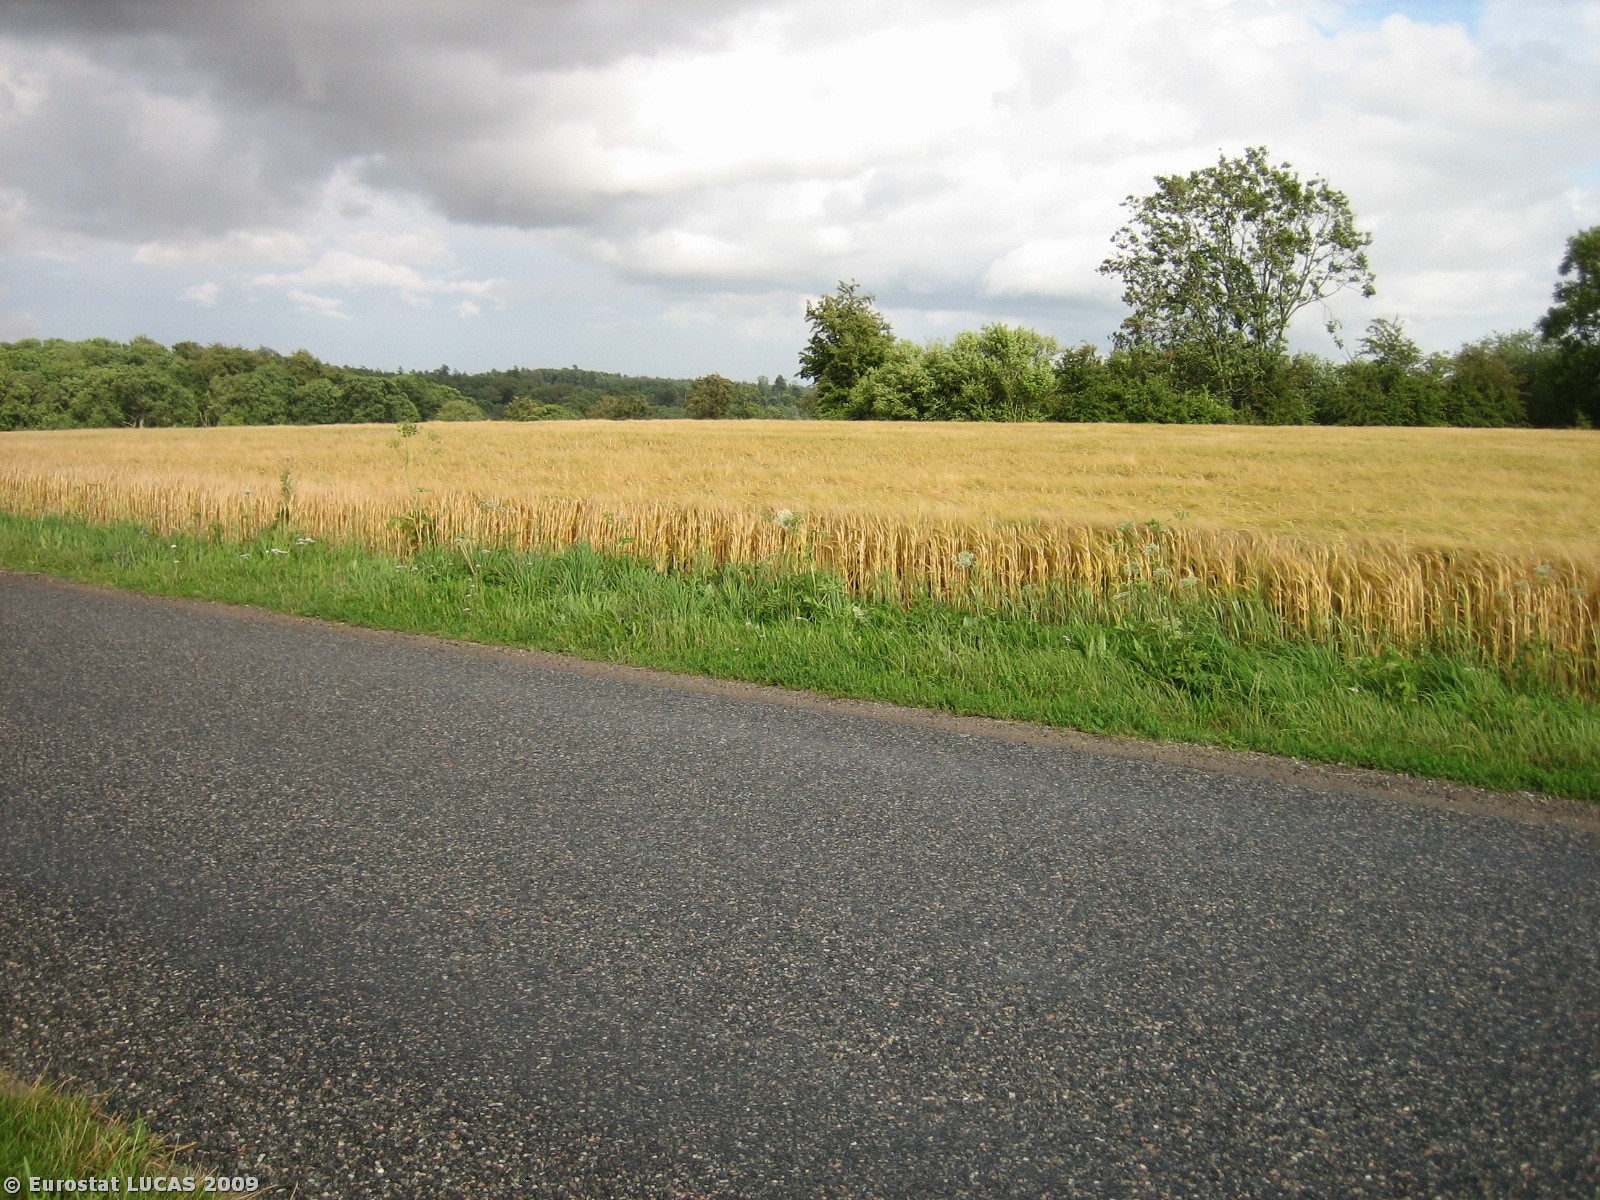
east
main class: Cropland
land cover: Barley
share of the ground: > 75 %
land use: Agriculture (excluding fallow land and kitchen gardens)
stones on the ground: < 10 %
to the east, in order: Barley; Grass margins; Paved roads, cycling and walking lanes; Grass margins; Barley
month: July
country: DK
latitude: 55.3968
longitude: 9.8580
